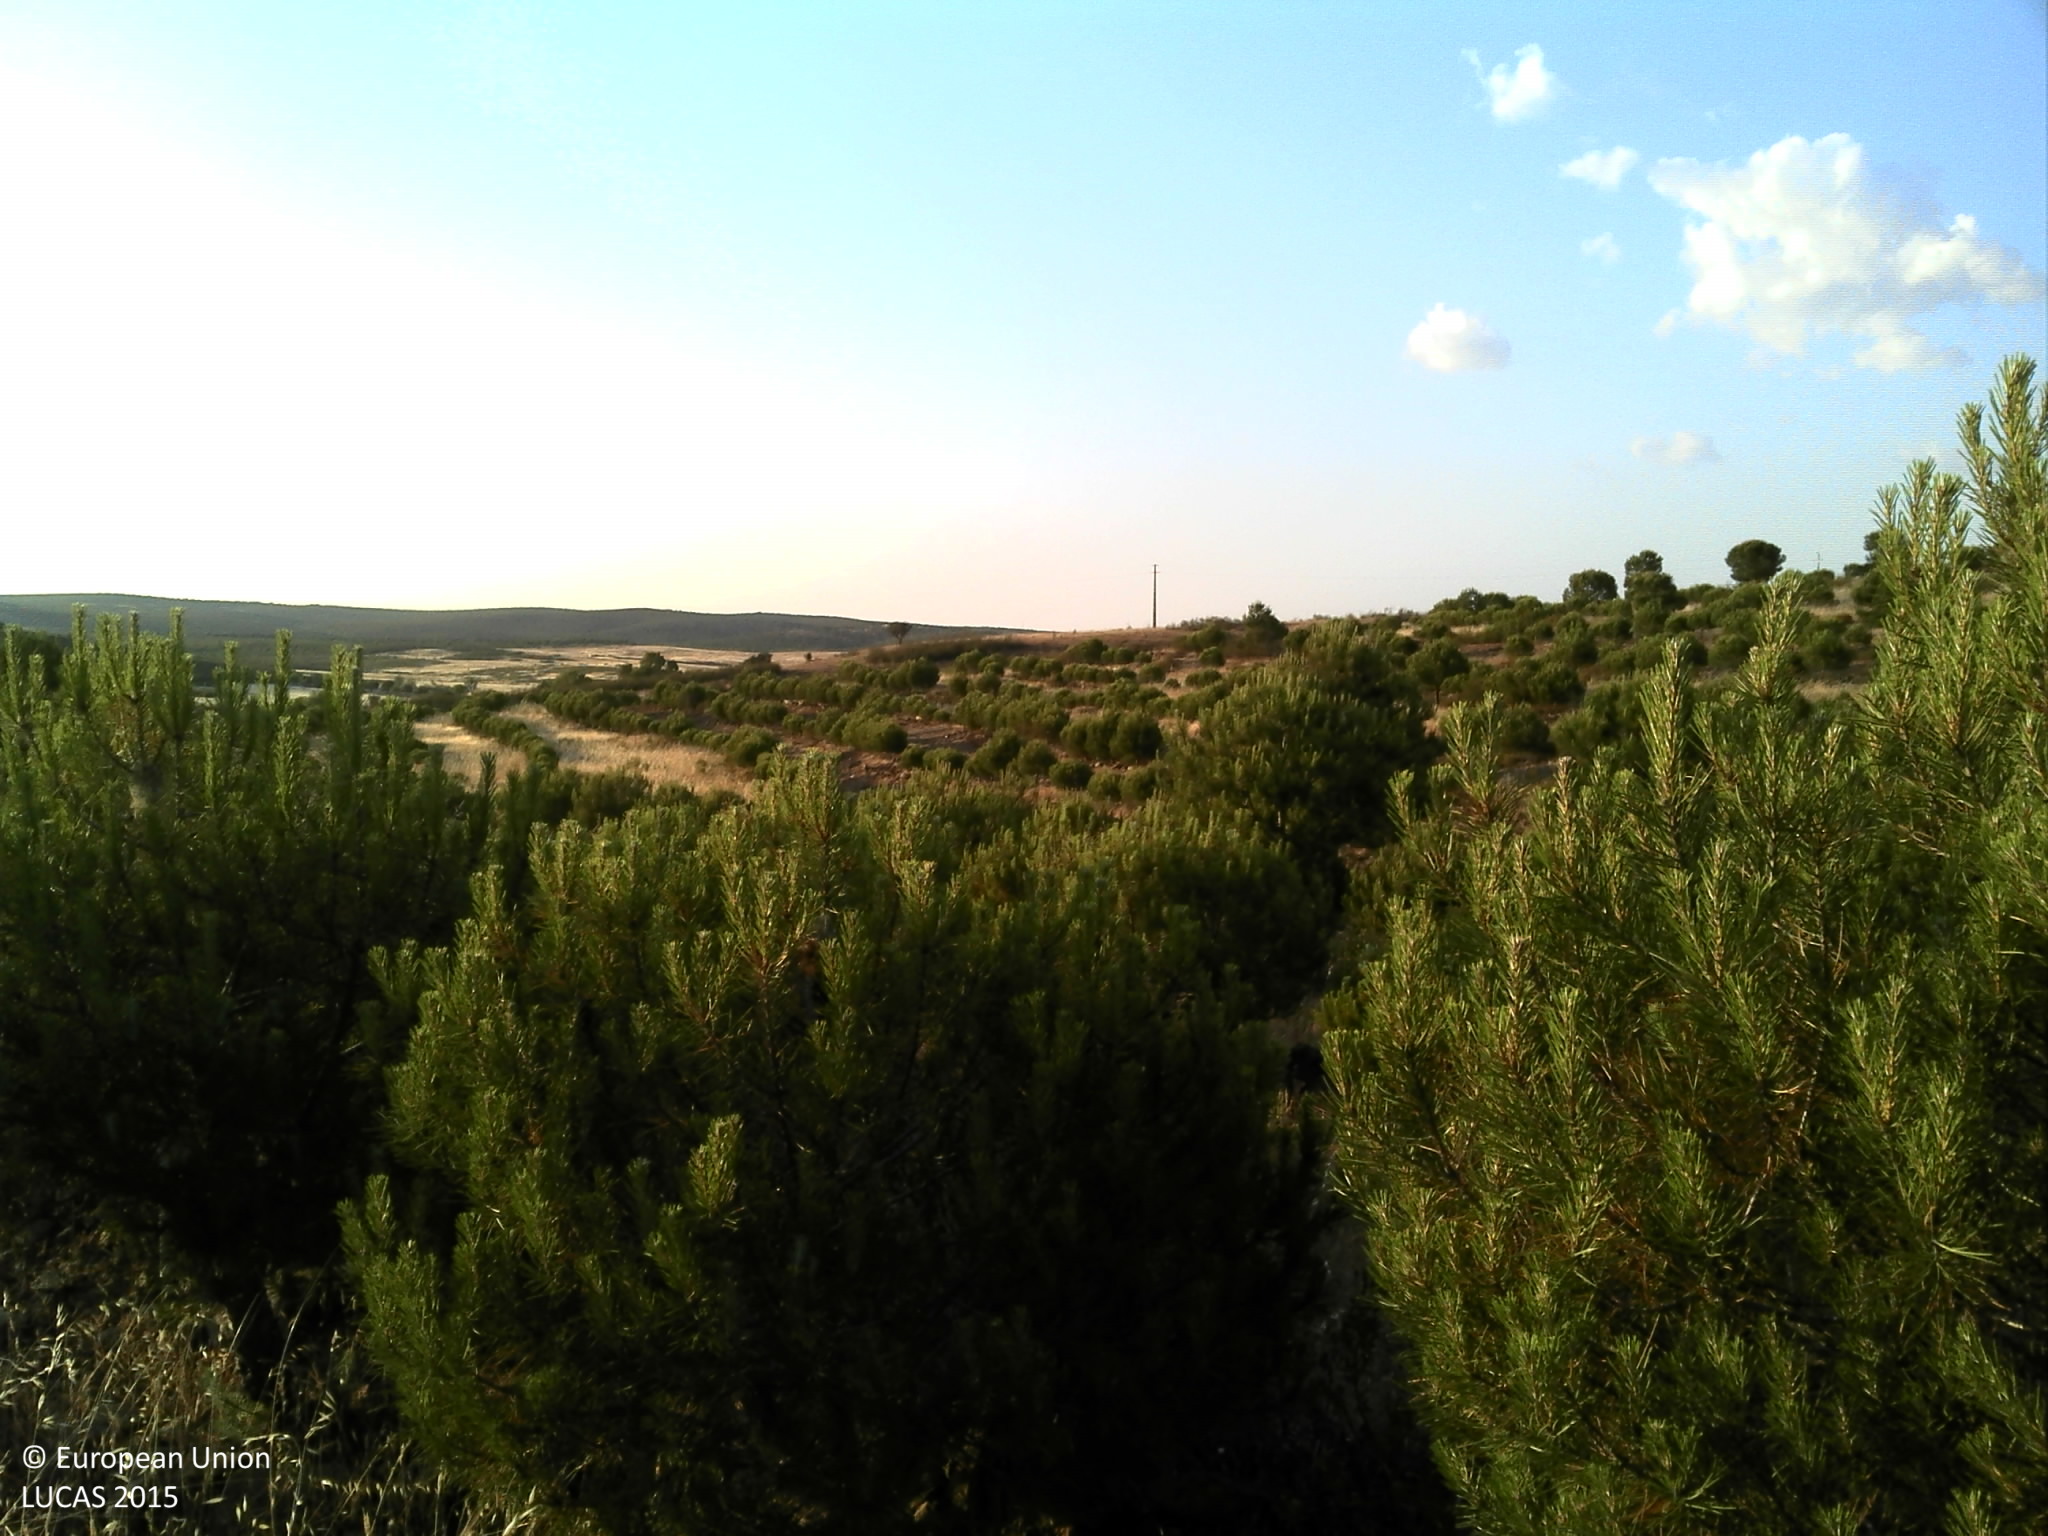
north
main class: Woodland
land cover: Pine dominated coniferous woodland
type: coniferous forest of the mediterranean region
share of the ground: 10 - 25 %
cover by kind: consolidated bare surface 50 %, coniferous forest trees 25 %, herbaceous plants 25 %
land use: Forestry
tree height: < 5 m
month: May
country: PT
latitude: 37.5039
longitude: -7.7638
